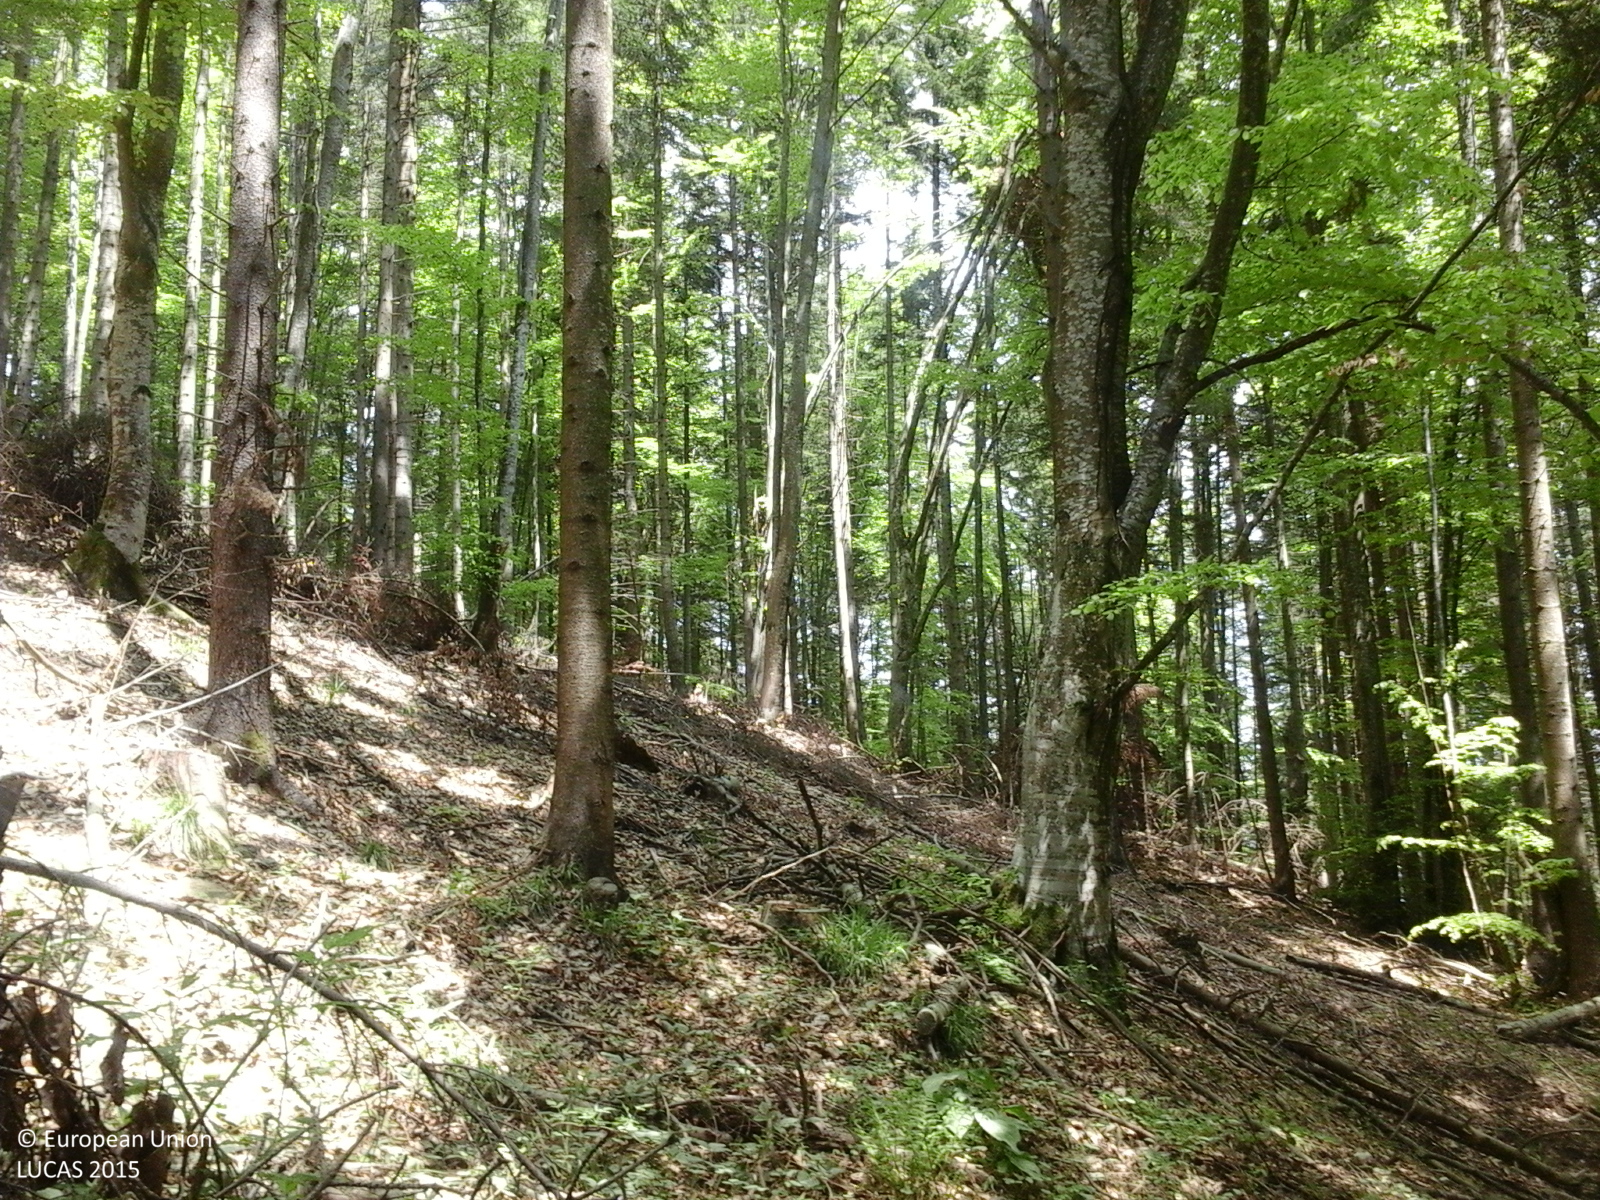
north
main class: Woodland
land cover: Spruce dominated mixed woodland
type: alpine coniferous forest
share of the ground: > 75 %
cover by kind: coniferous forest trees 75 %, broadleaved forest trees 25 %
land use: Forestry
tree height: > 5 m
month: May
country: RO
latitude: 45.9857
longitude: 26.3262
